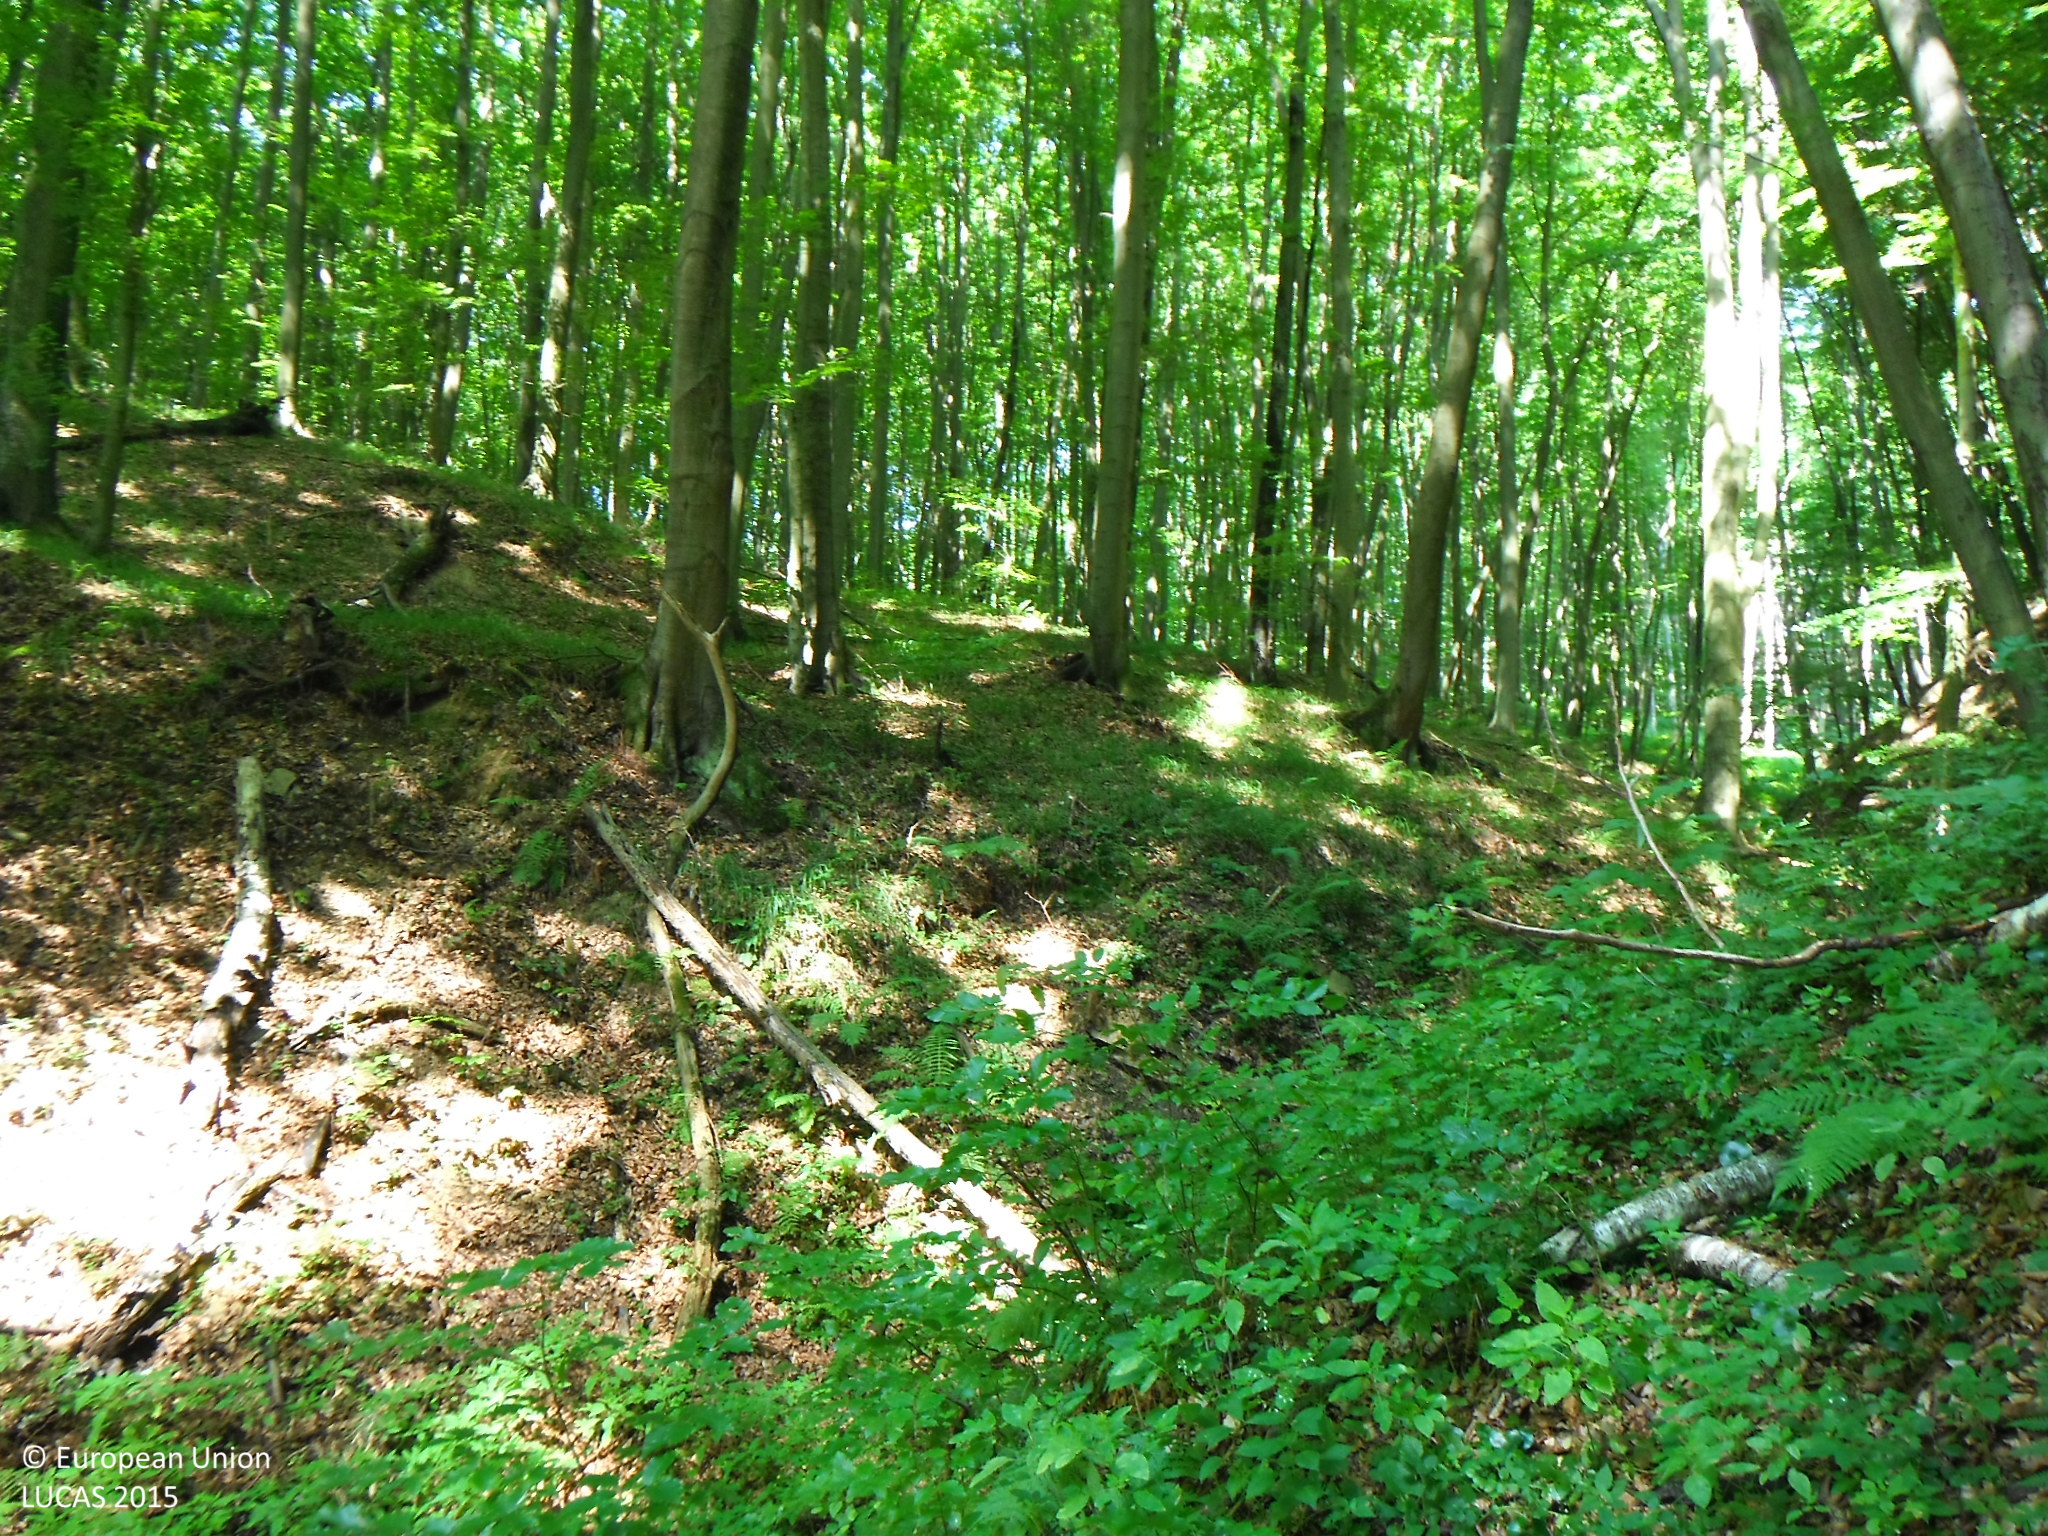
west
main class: Woodland
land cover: Broadleaved woodland
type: beech forest
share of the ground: > 75 %
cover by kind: broadleaved forest trees 90 %, herbaceous plants 10 %
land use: Forestry
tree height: > 5 m
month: July
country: SK
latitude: 49.2612
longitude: 21.4395
